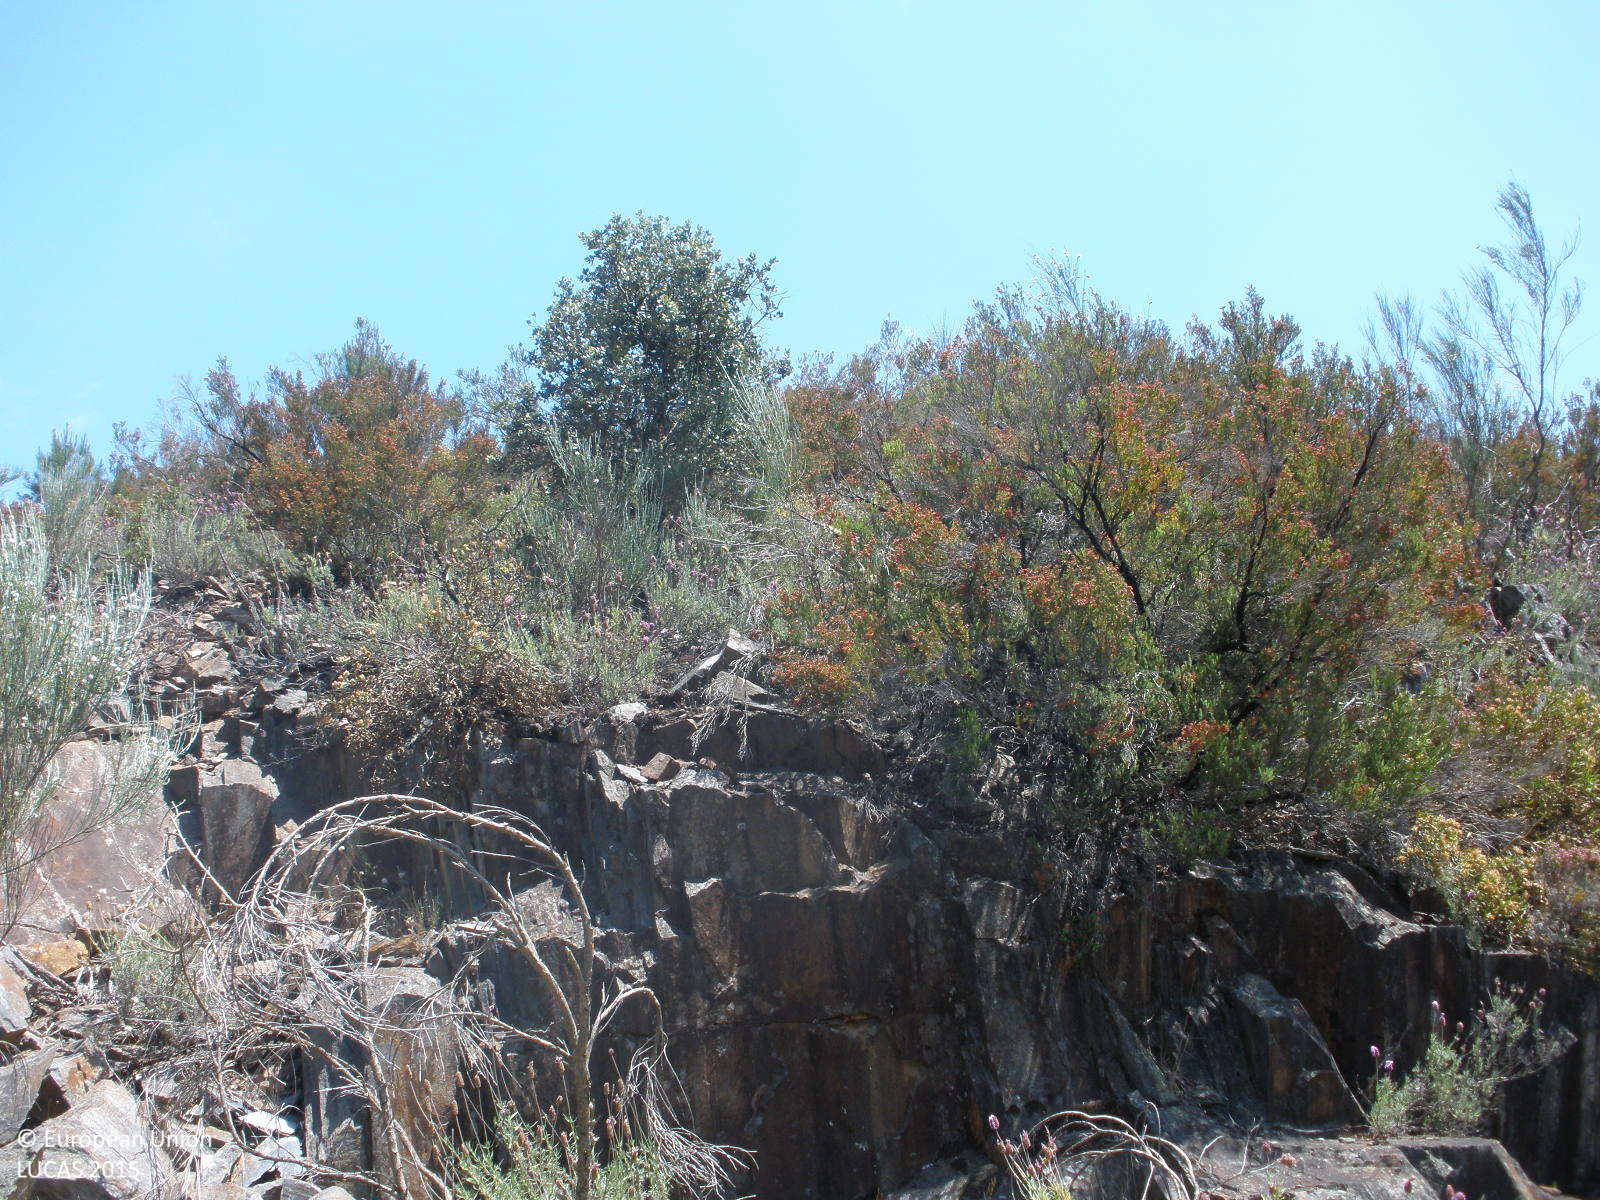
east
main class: Shrubland
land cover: Shrubland with sparse tree cover
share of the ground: > 75 %
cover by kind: shrubs 95 %, coniferous forest trees 5 %
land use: Forestry
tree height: < 5 m
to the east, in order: Shrubland with sparse tree cover; Rivers and streams; Shrubland with sparse tree cover
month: June
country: ES
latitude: 40.5059
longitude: -6.2373
